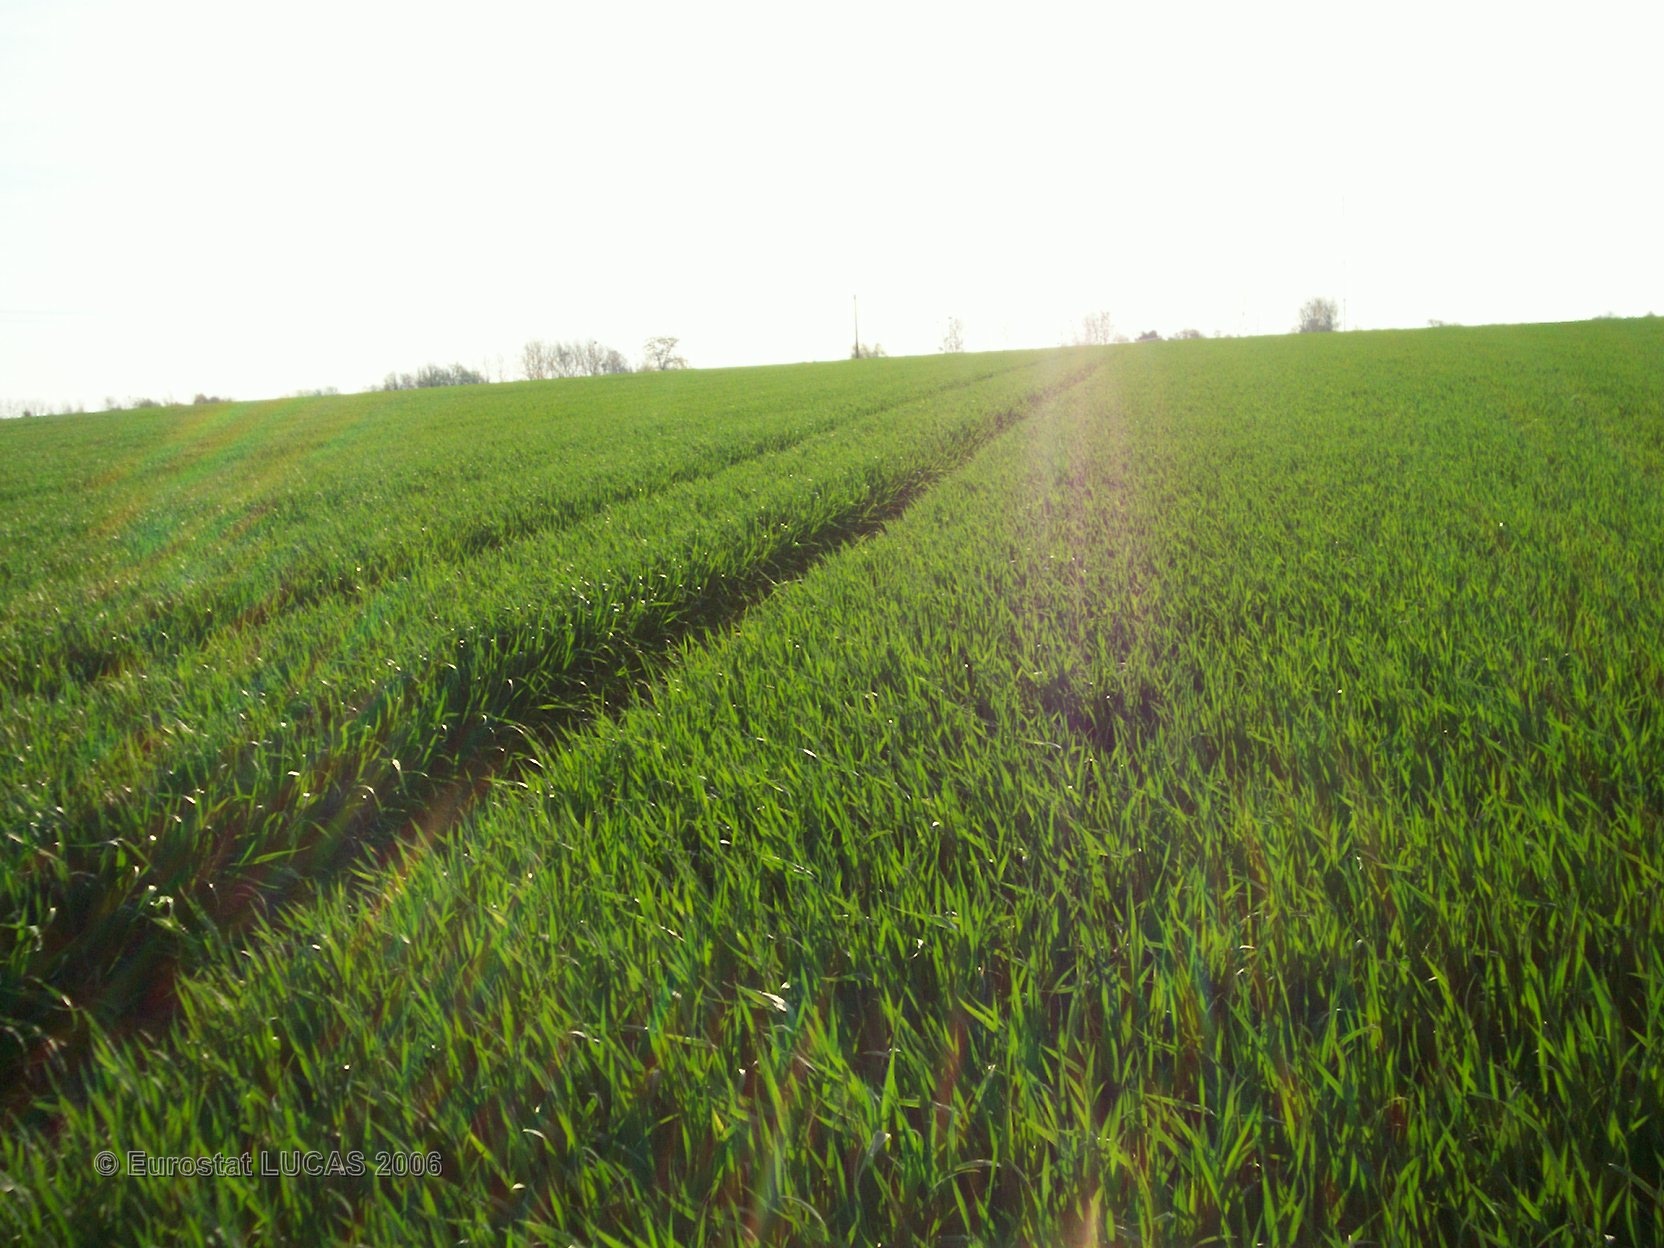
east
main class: Cropland
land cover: Common wheat
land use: Agriculture (excluding fallow land and kitchen gardens)
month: April
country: FR
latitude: 46.5815
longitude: 1.5990
